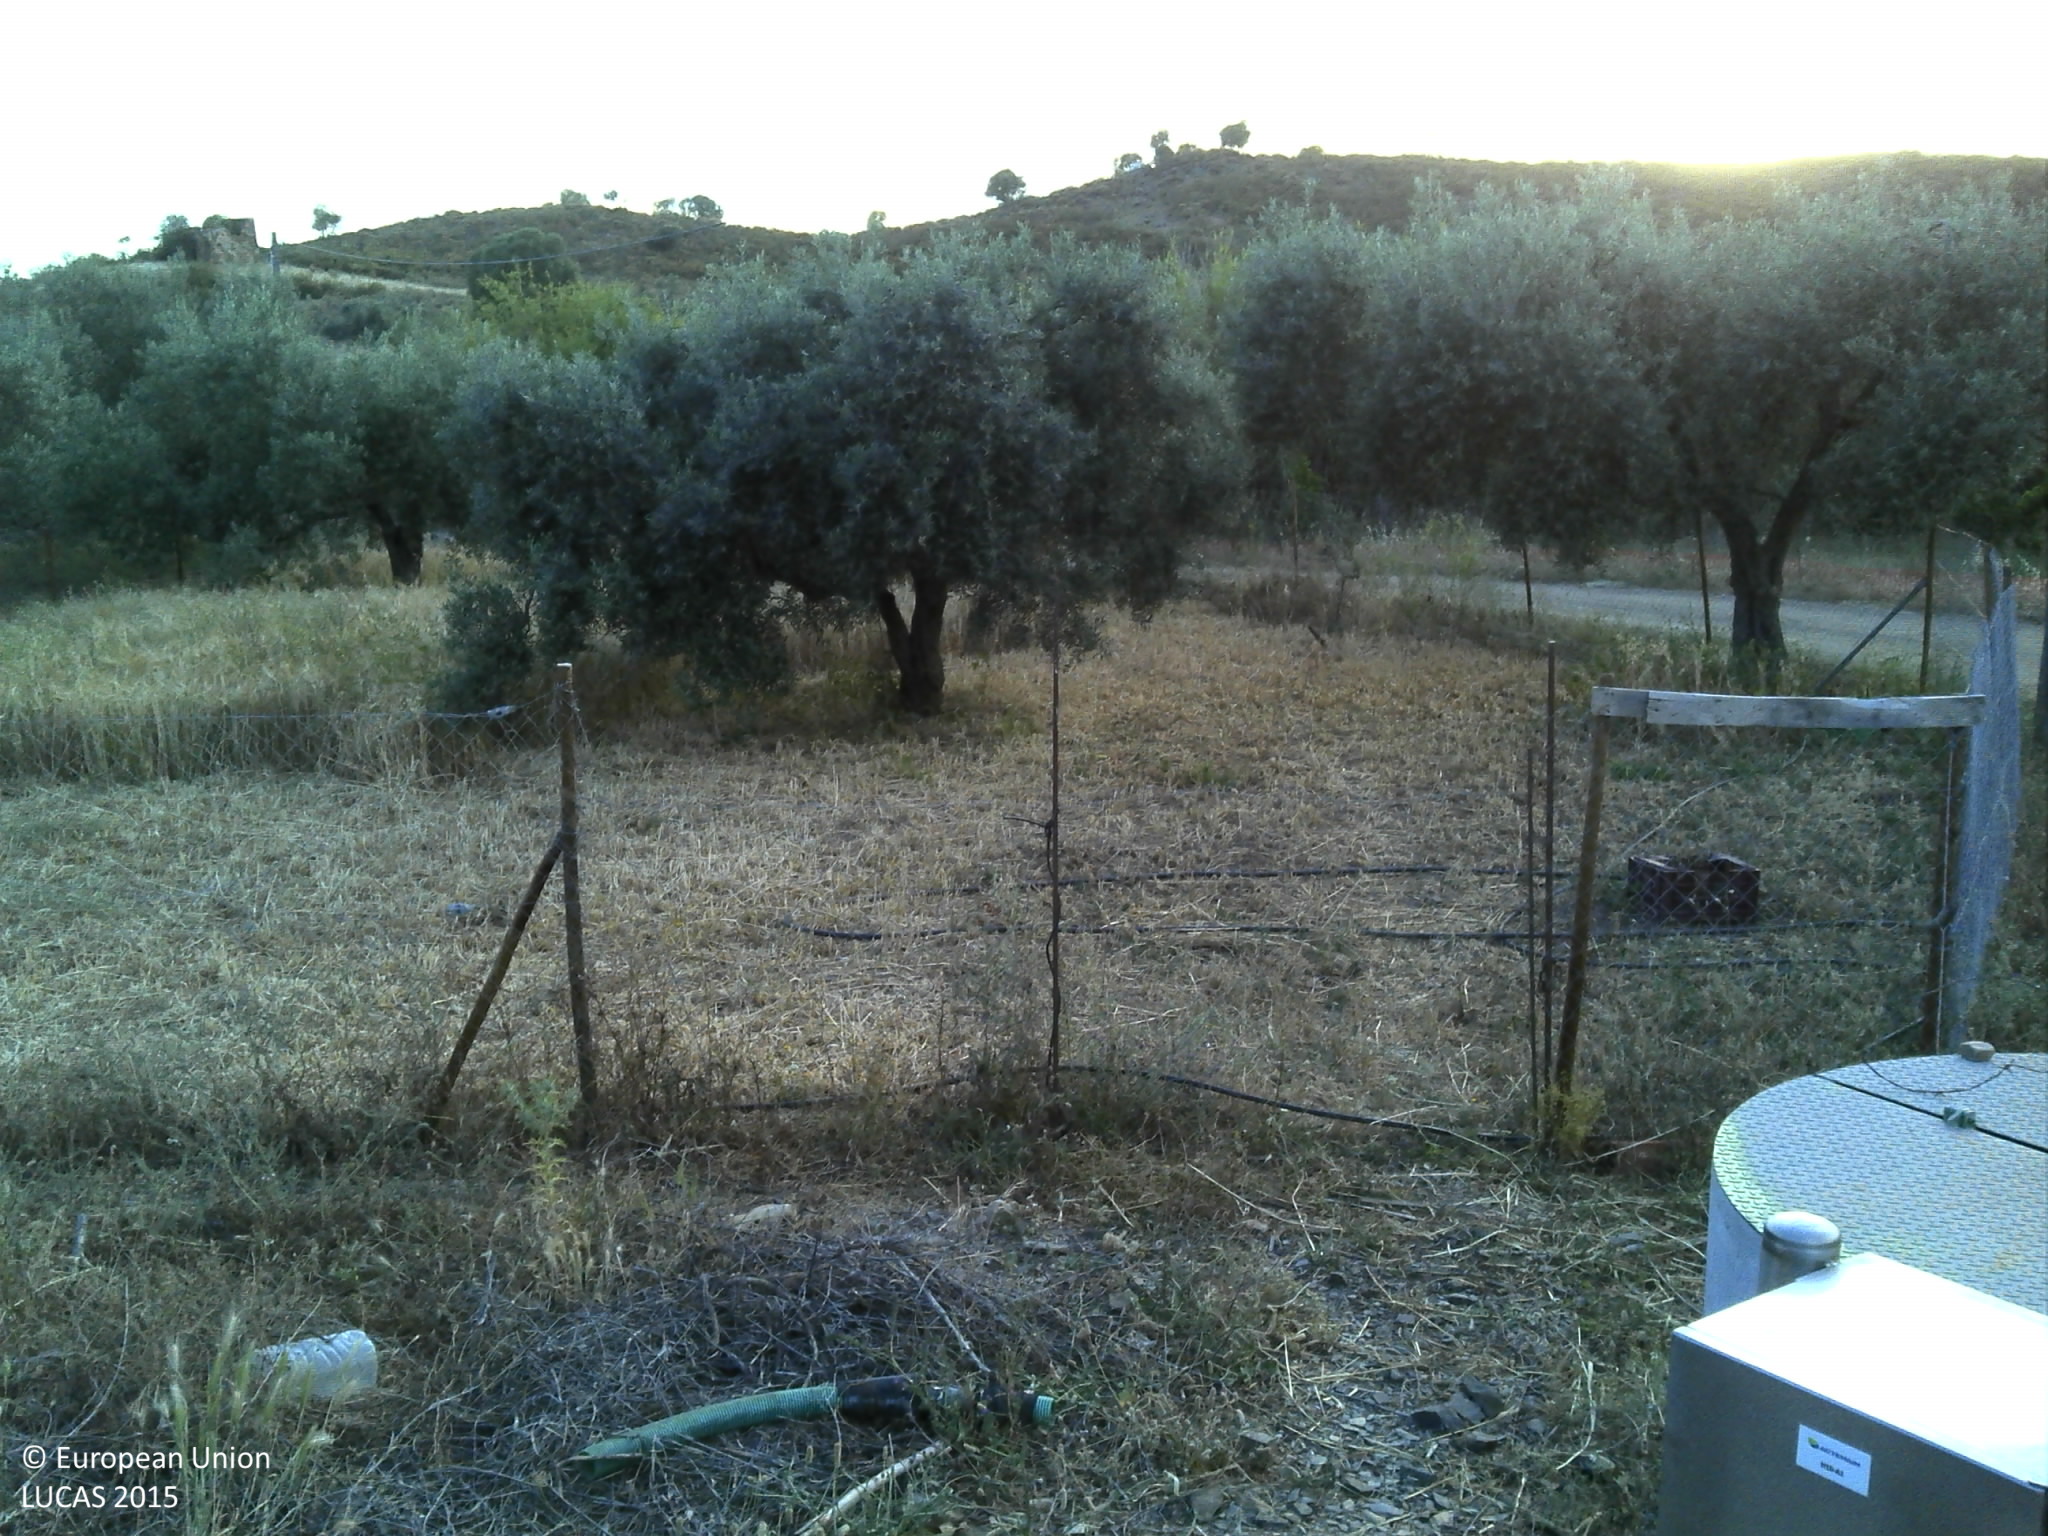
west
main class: Grassland
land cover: Grassland with sparse tree/shrub cover
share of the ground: 25 - 50 %
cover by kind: herbaceous plants 45 %, unconsolidated bare surface 40 %, broadleaved forest trees 5 %
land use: Abandoned areas
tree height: < 5 m
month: May
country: PT
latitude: 37.2769
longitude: -7.4969
